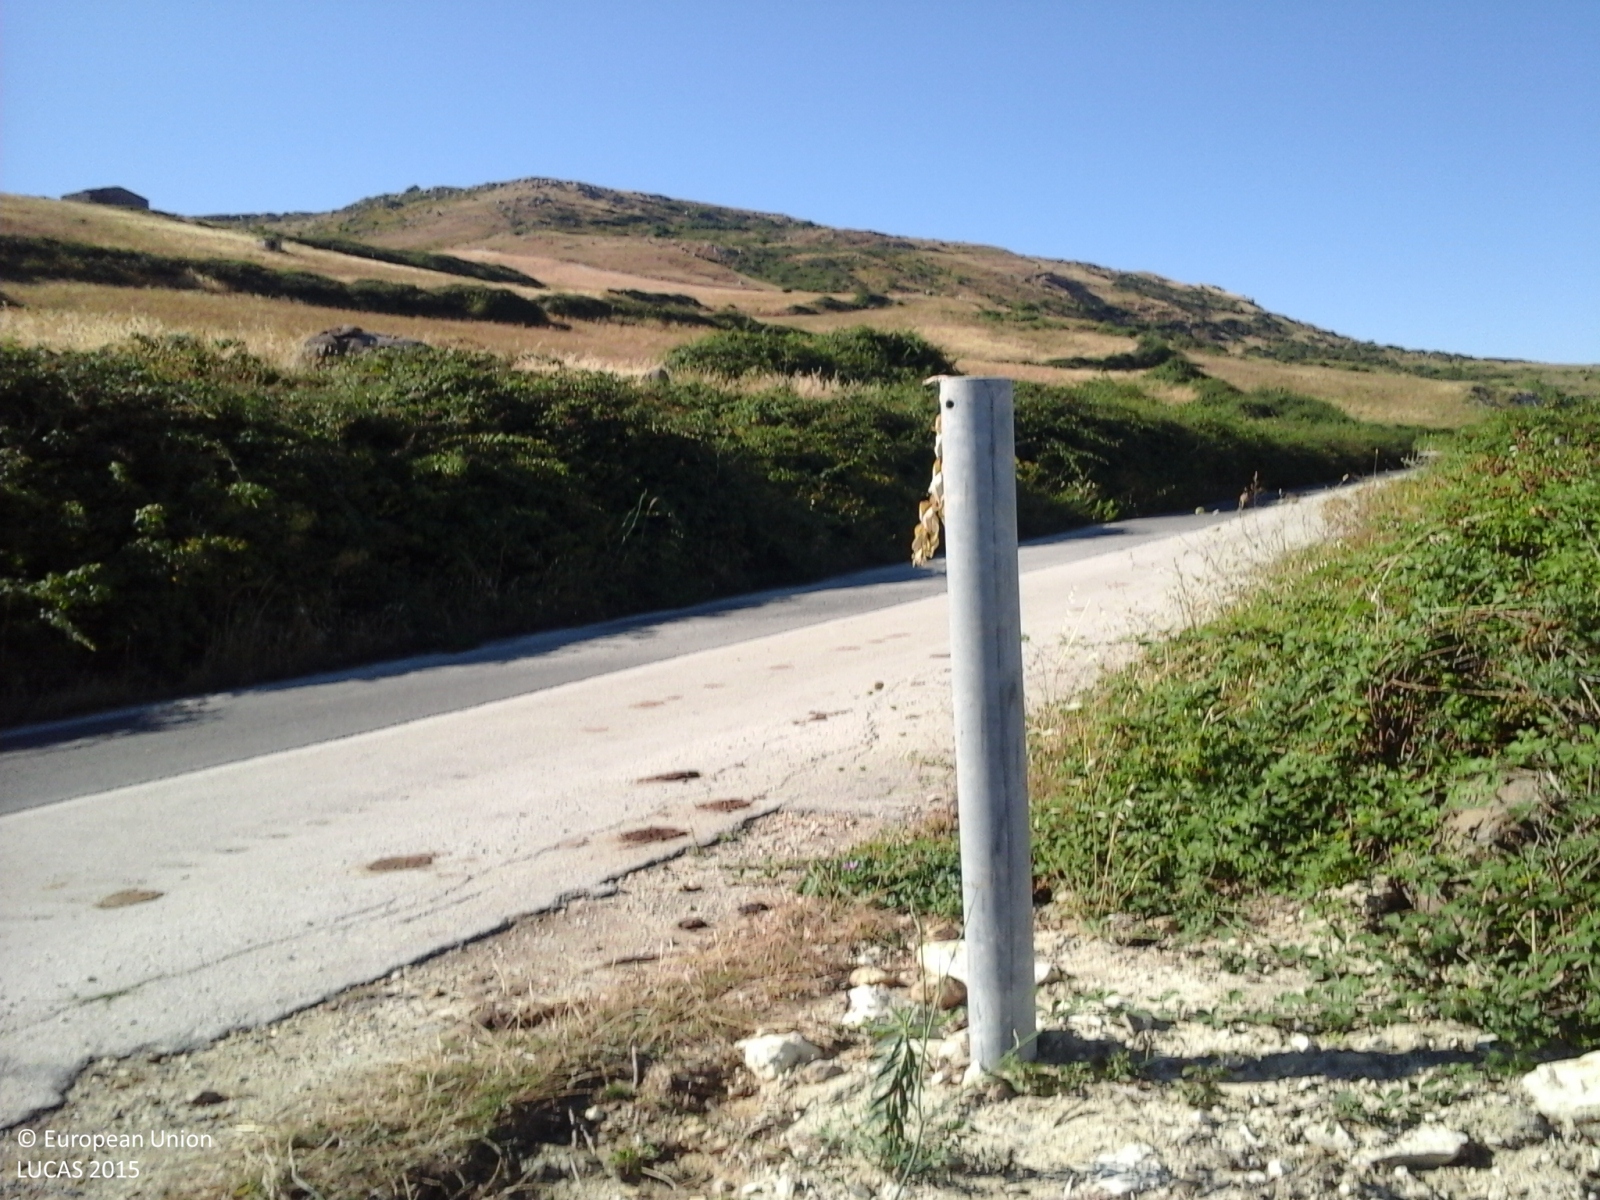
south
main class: Cropland
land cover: Temporary grasslands
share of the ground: > 75 %
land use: Agriculture (excluding fallow land and kitchen gardens)
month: July
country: IT
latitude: 37.1345
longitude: 14.8148
